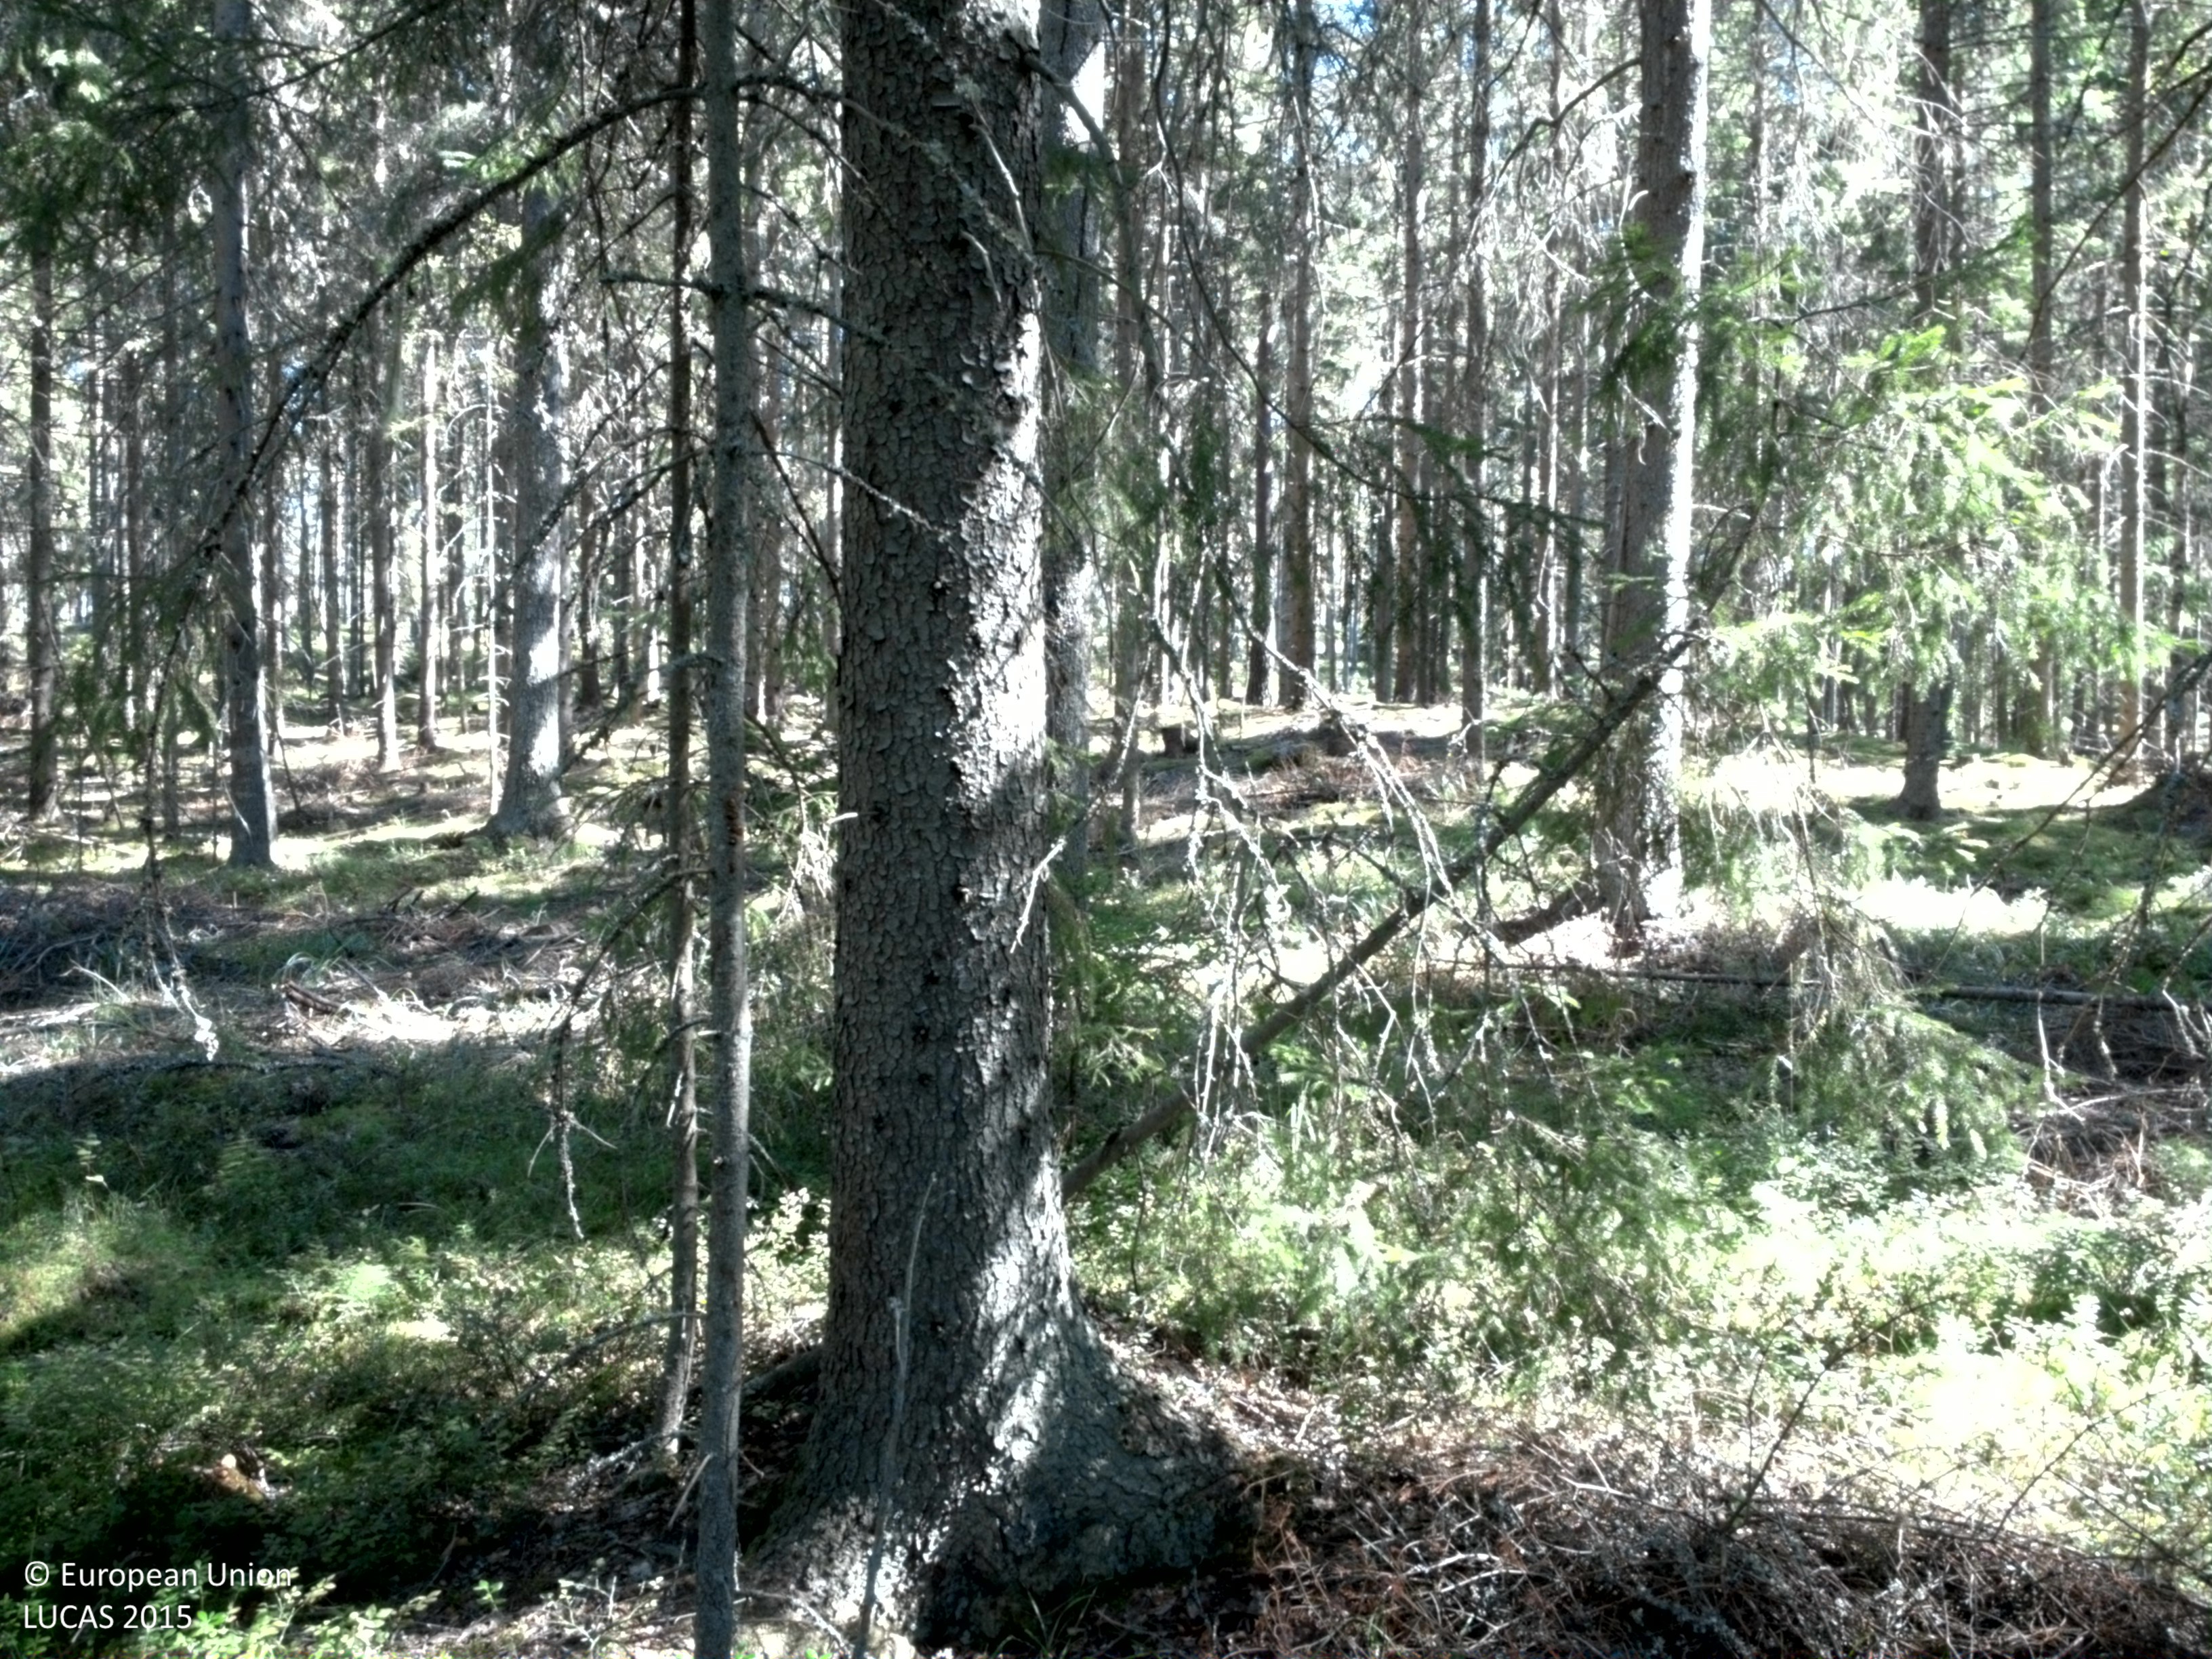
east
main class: Woodland
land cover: Spruce dominated coniferous woodland
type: boreal forest
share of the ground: > 75 %
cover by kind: coniferous forest trees 75 %, lichens and mosses 15 %, shrubs 10 %
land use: Forestry
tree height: > 5 m
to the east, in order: Spruce dominated coniferous woodland; Tracks; Pine dominated coniferous woodland; Grass margins; Paved roads, cycling and walking lanes; Grass margins; Pine dominated coniferous woodland; Electric lines; Pine dominated coniferous woodland; Tracks; Pine dominated coniferous woodland
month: August
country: SE
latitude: 59.6764
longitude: 15.9396
